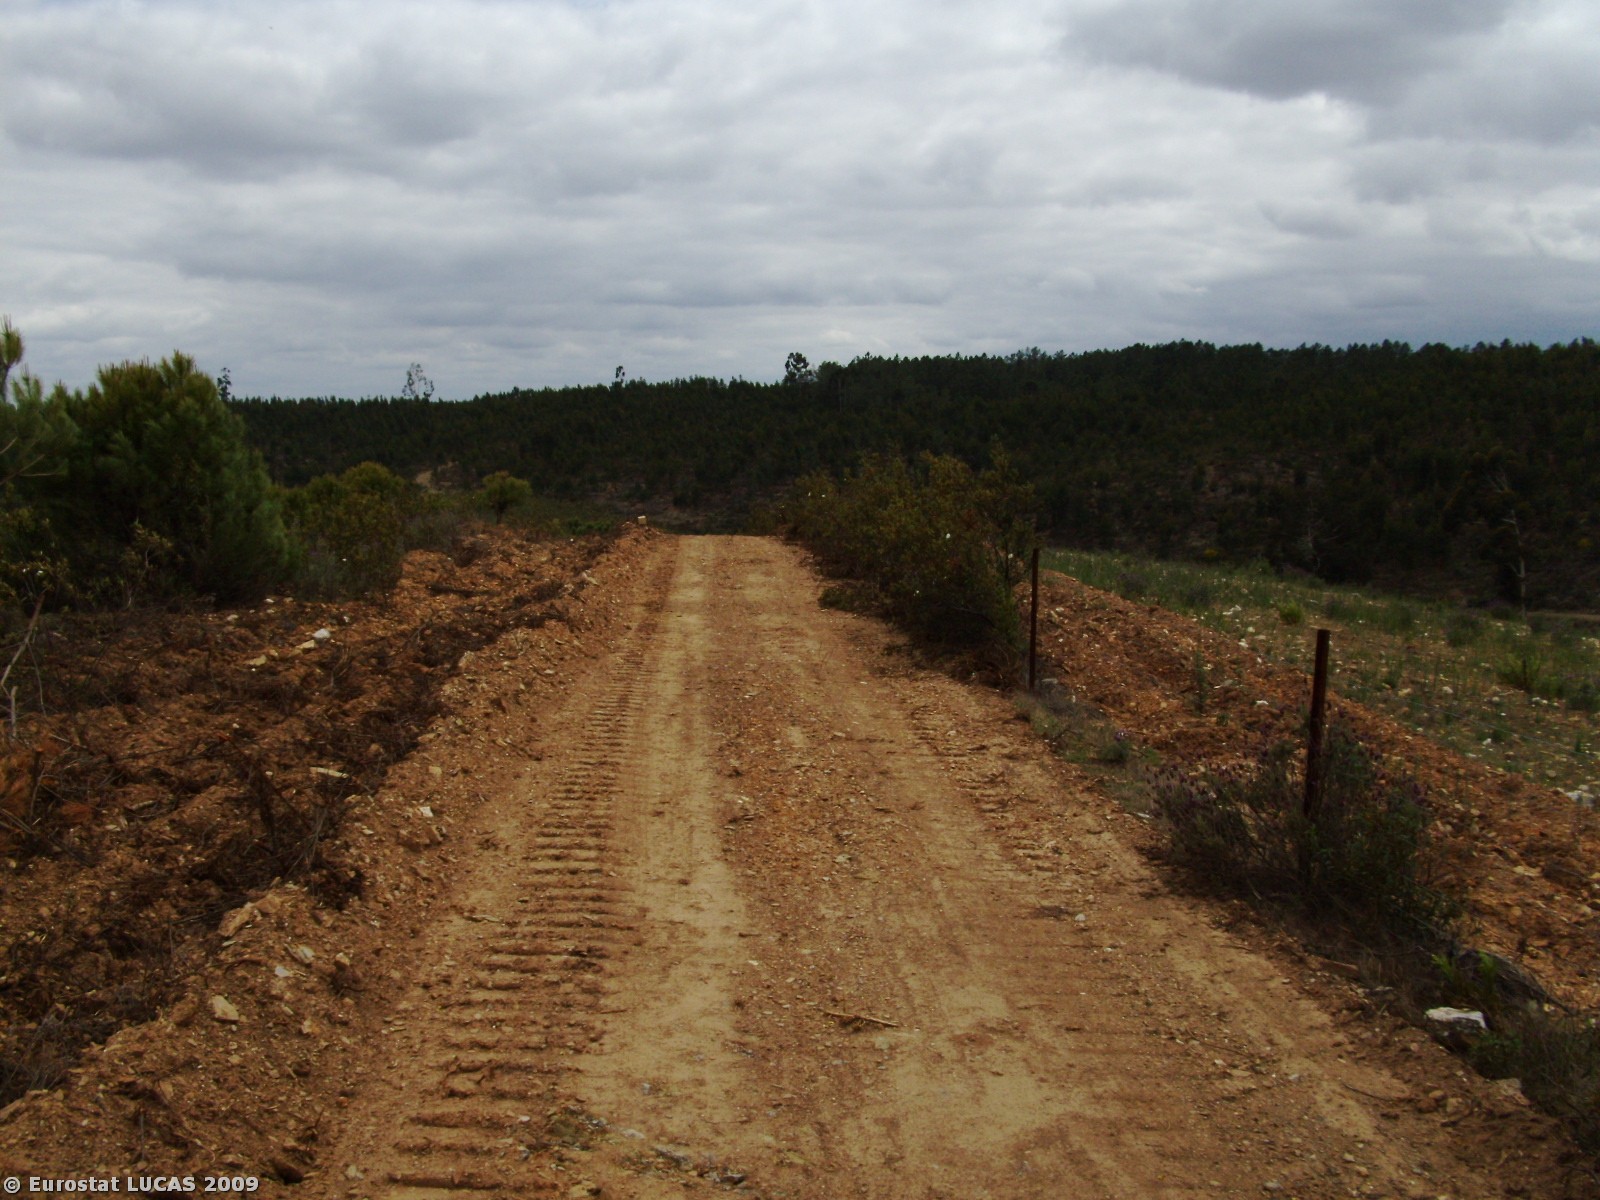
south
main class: Grassland
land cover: Spontaneously vegetated surfaces
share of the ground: > 75 %
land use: Fallow land
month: April
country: PT
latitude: 39.7865
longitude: -7.5092
